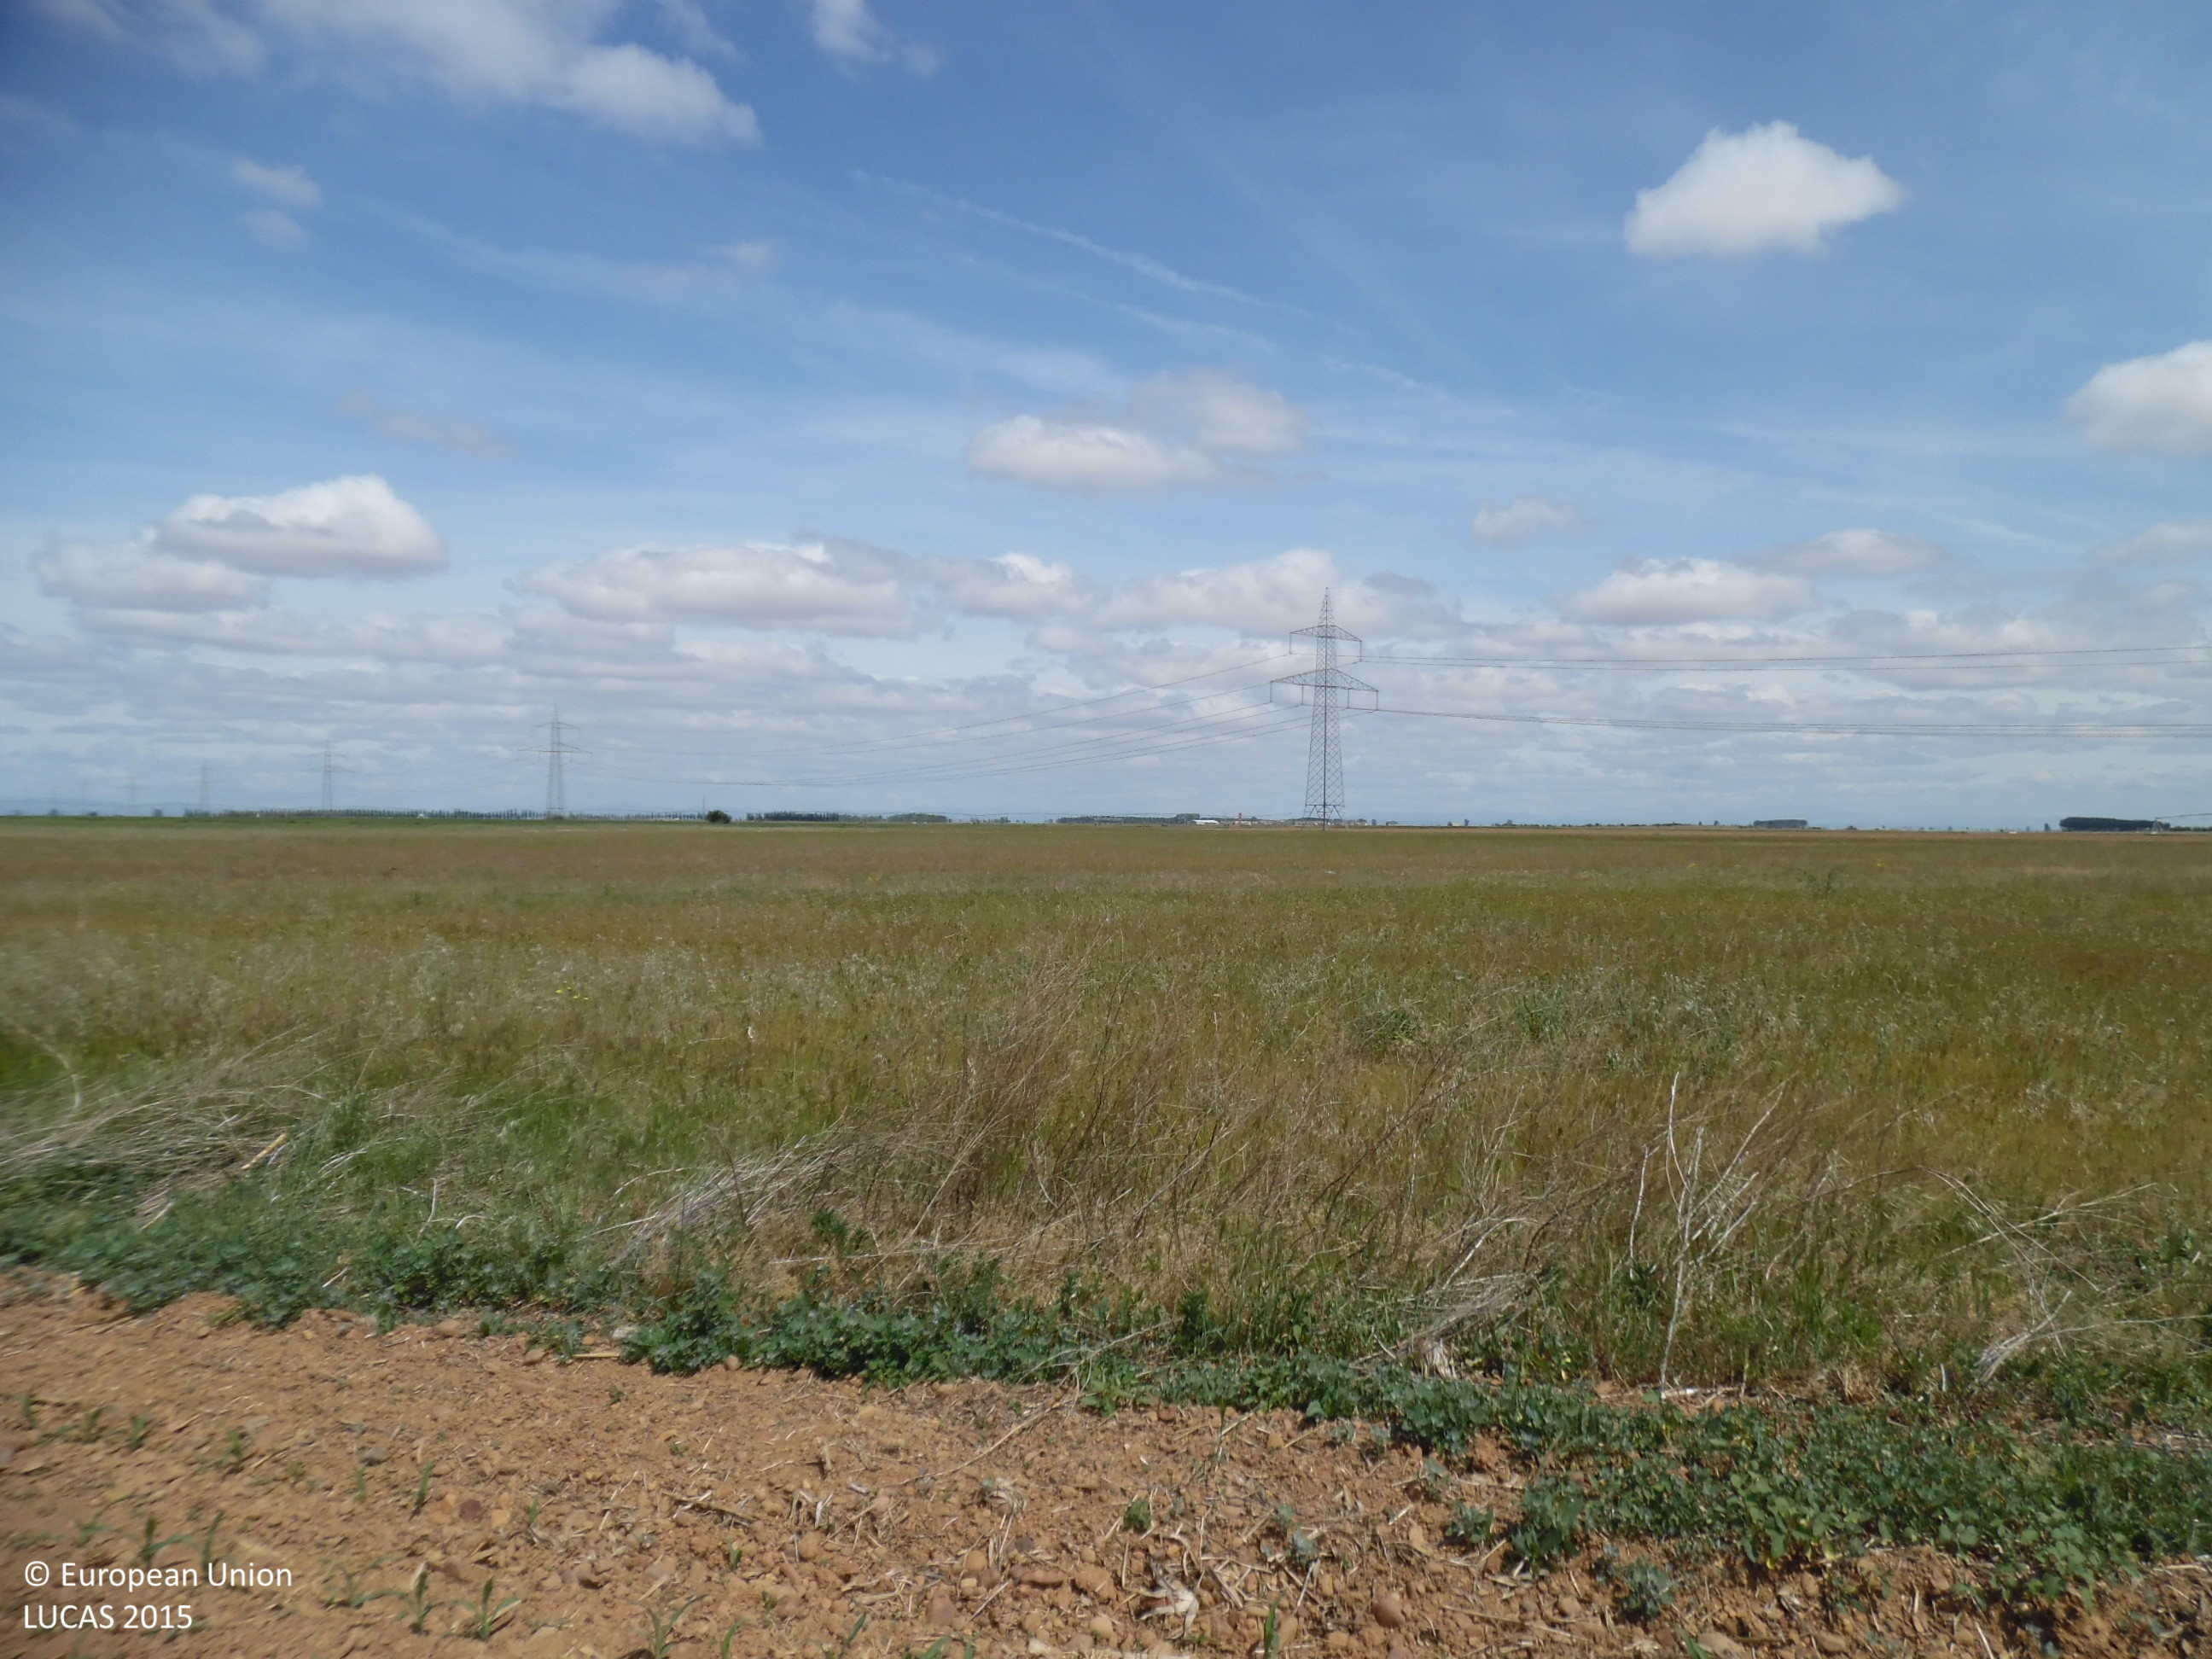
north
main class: Cropland
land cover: Maize
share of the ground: < 10 %
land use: Agriculture (excluding fallow land and kitchen gardens)
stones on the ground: 10 - 25 %
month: May
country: ES
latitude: 42.2091
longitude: -5.7082
